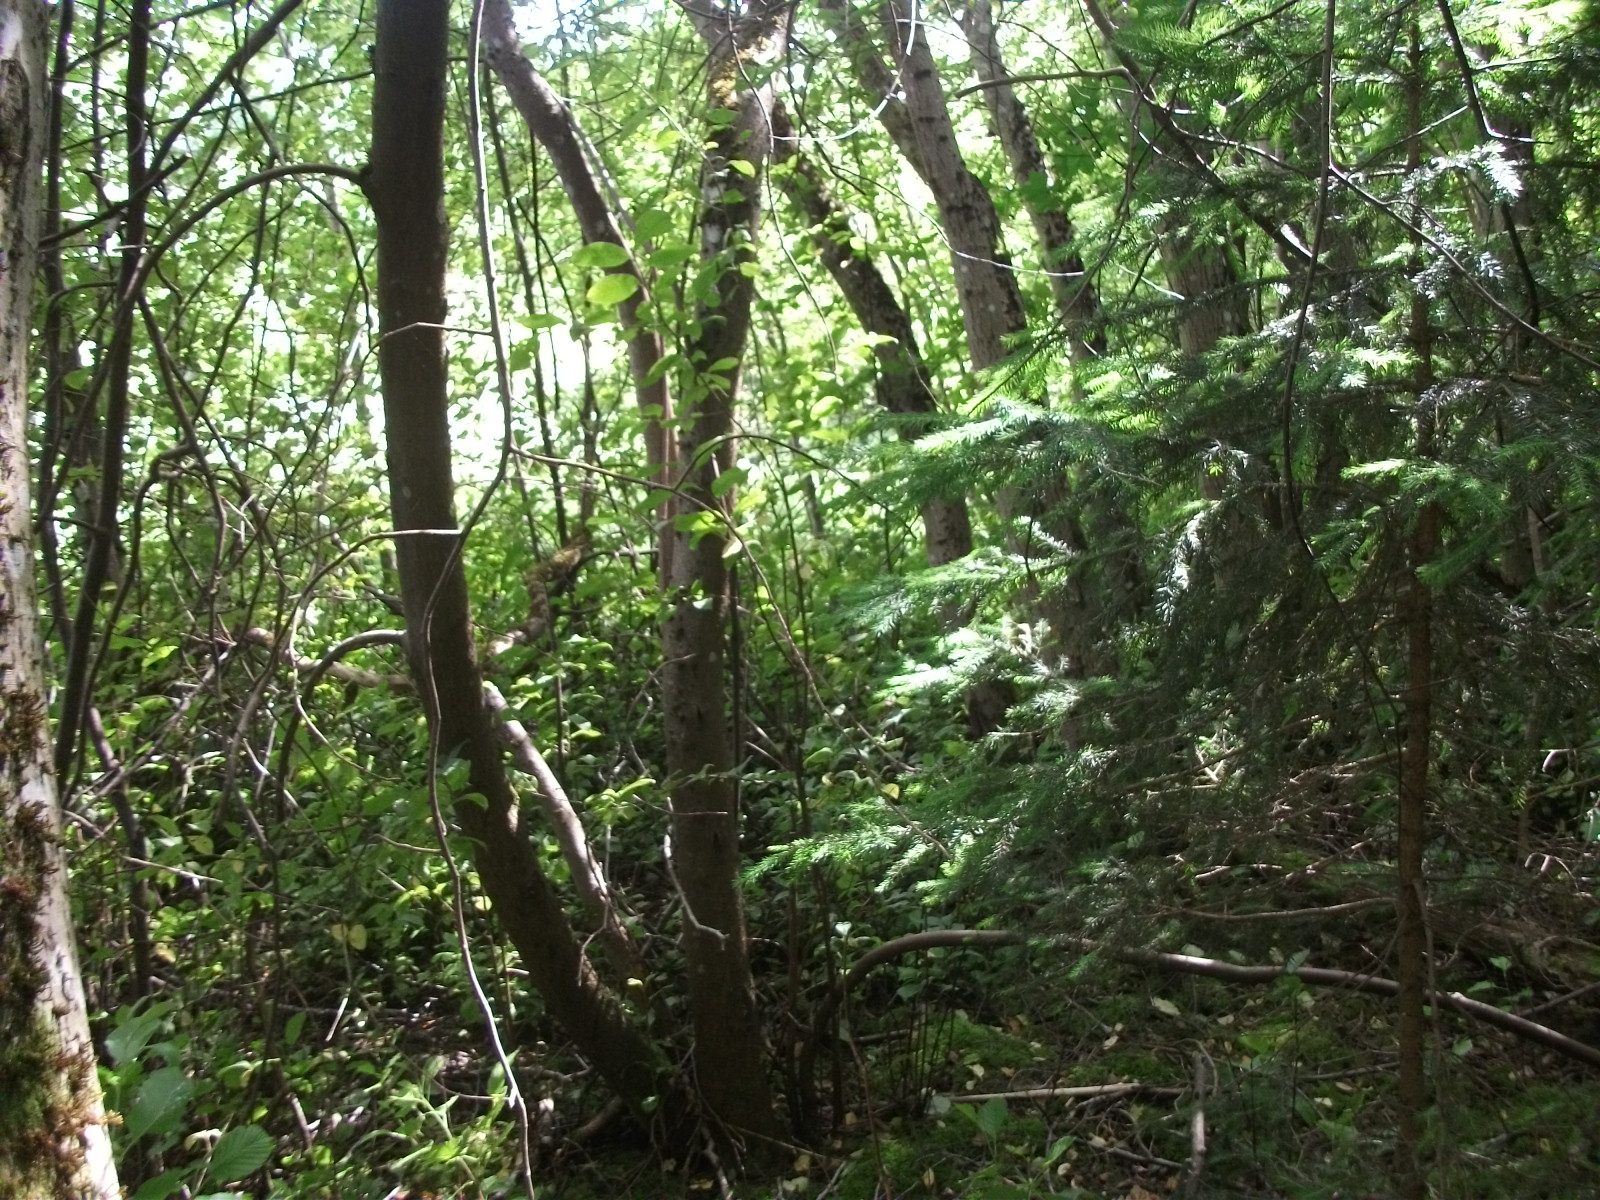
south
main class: Woodland
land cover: Spruce dominated mixed woodland
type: hemiboreal forest and nemoral coniferous forest and mixed broadleaved-coniferous forest
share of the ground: > 75 %
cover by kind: coniferous forest trees 60 %, broadleaved forest trees 30 %, herbaceous plants 10 %
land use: Forestry
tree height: > 5 m
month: July
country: LV
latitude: 57.1301
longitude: 25.9387
